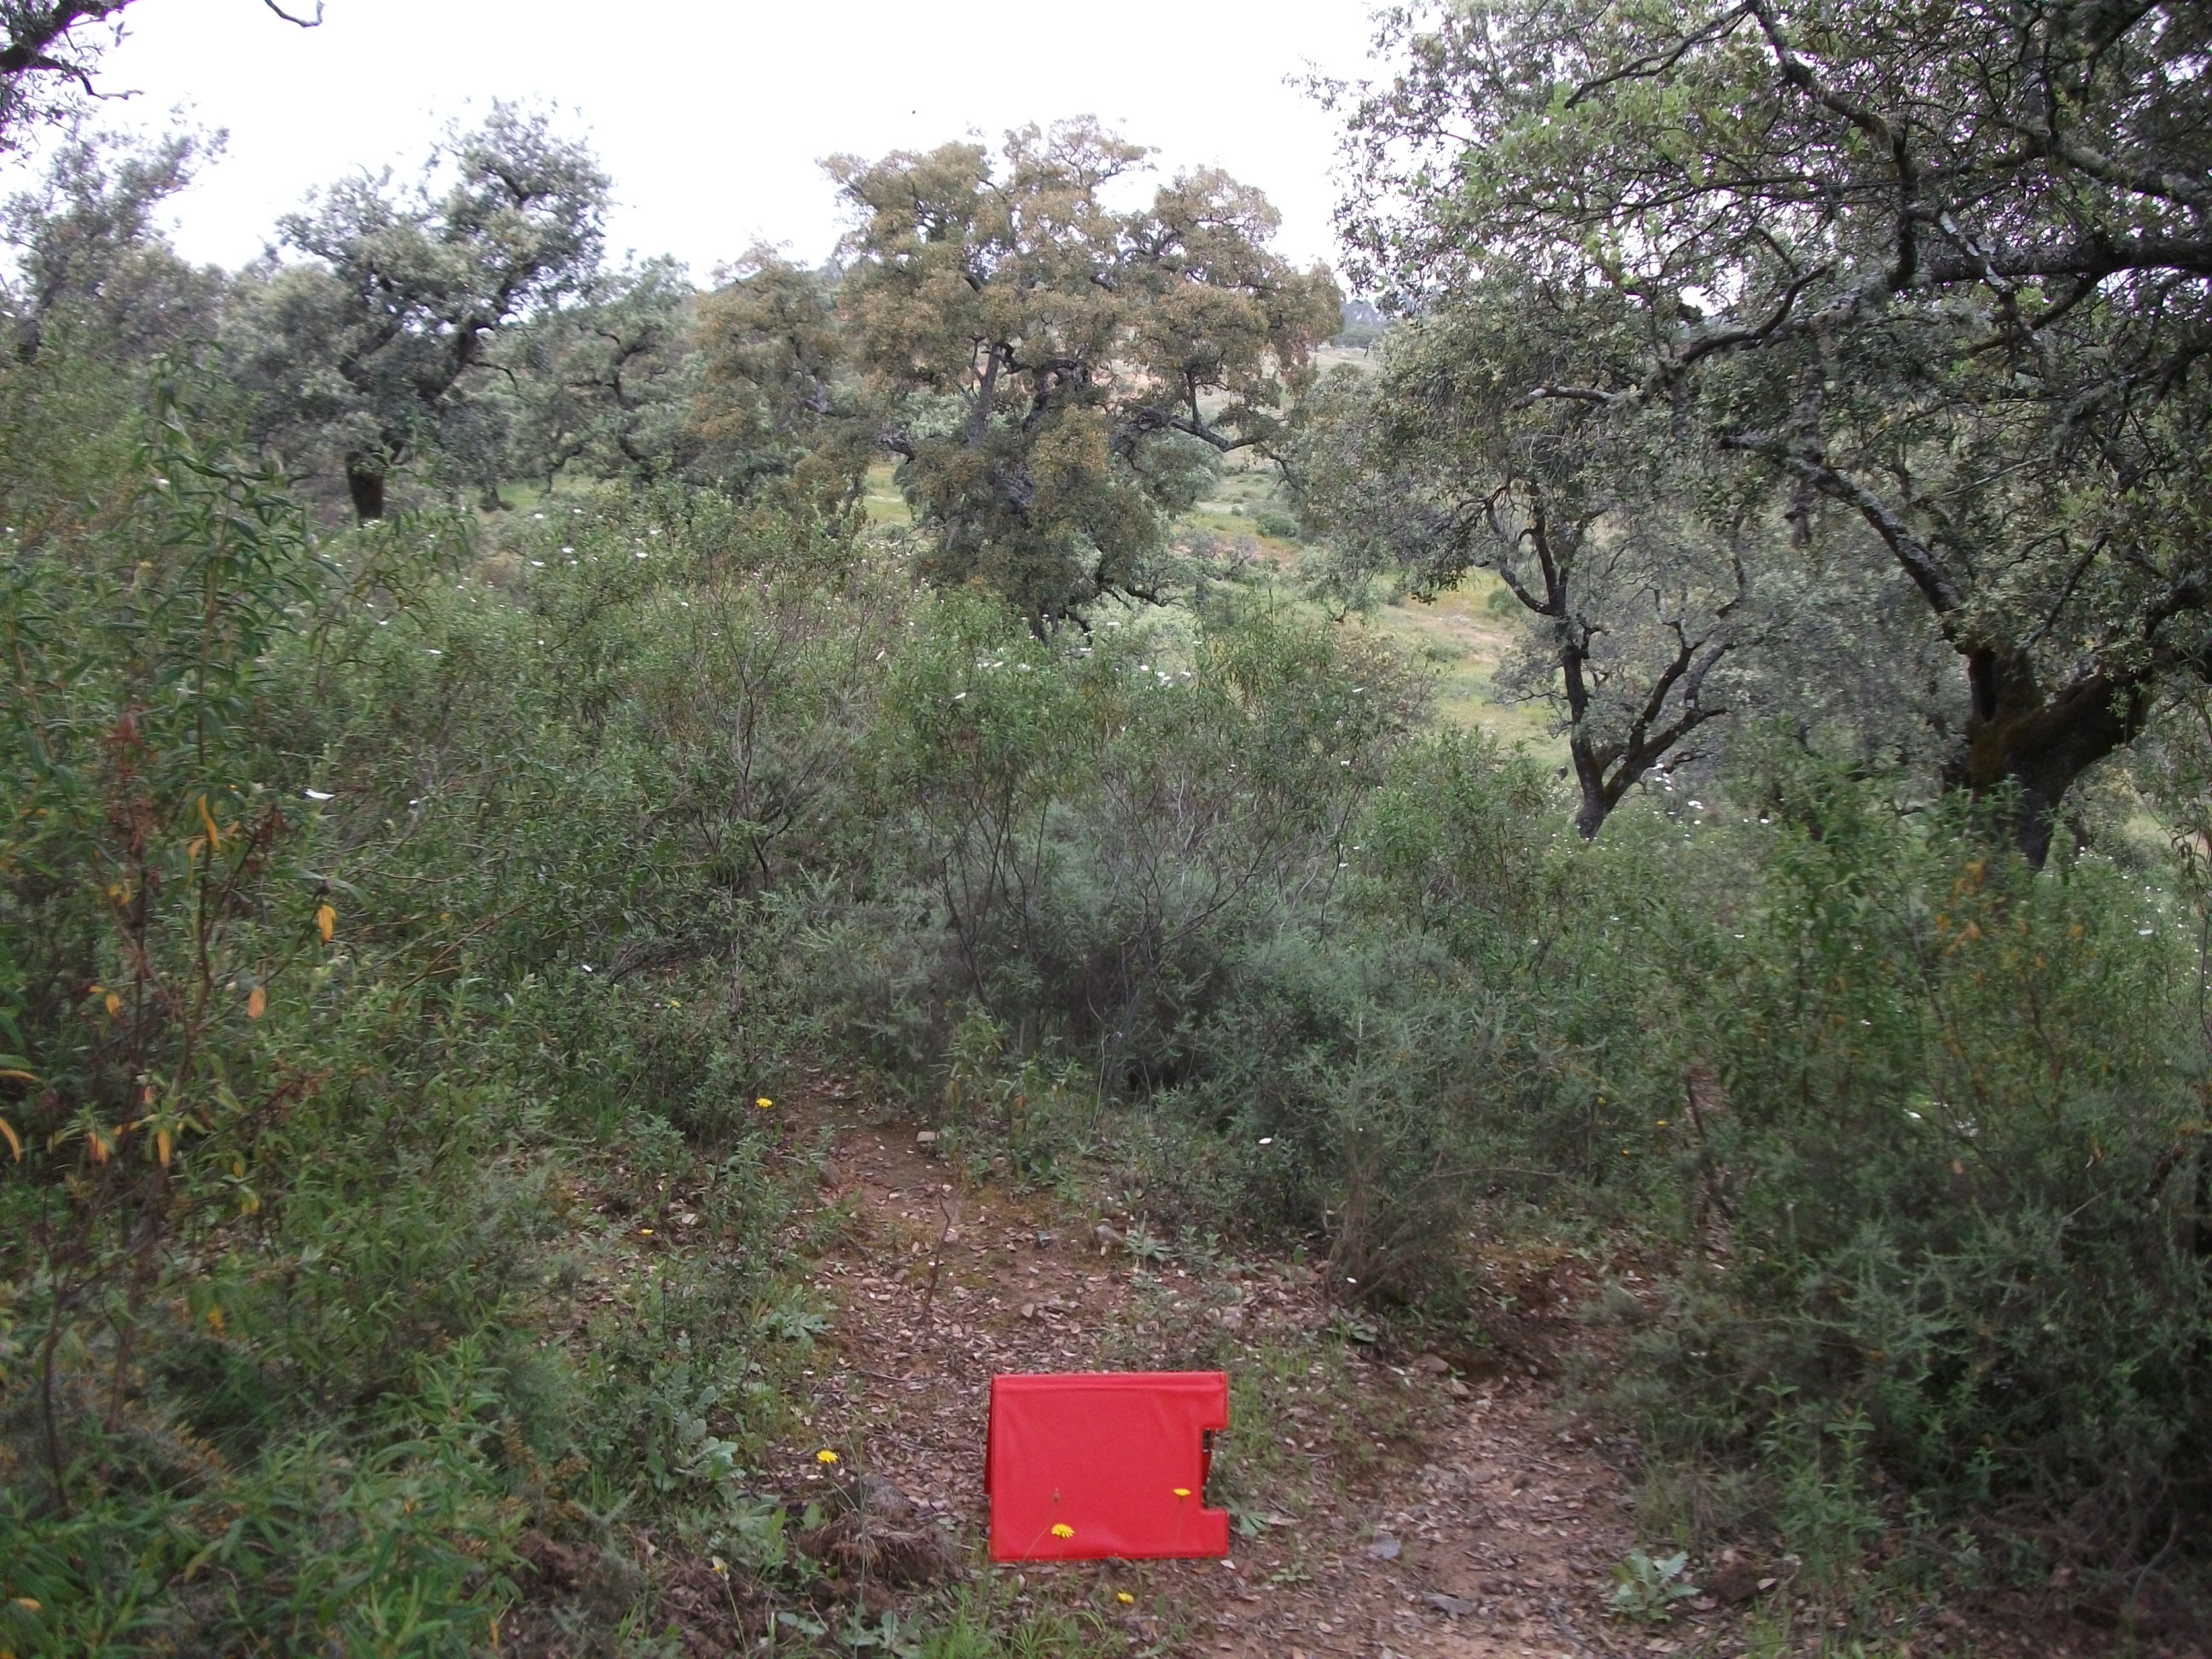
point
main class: Woodland
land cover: Broadleaved woodland
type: broadleaved evergreen forest
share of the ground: 25 - 50 %
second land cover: Shrubland without tree cover
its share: > 75 %
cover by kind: broadleaved forest trees 50 %, shrubs 45 %, herbaceous plants 5 %
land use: Forestry
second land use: Agriculture (excluding fallow land and kitchen gardens)
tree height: > 5 m
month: April
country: ES
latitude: 37.8403
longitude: -6.7384
